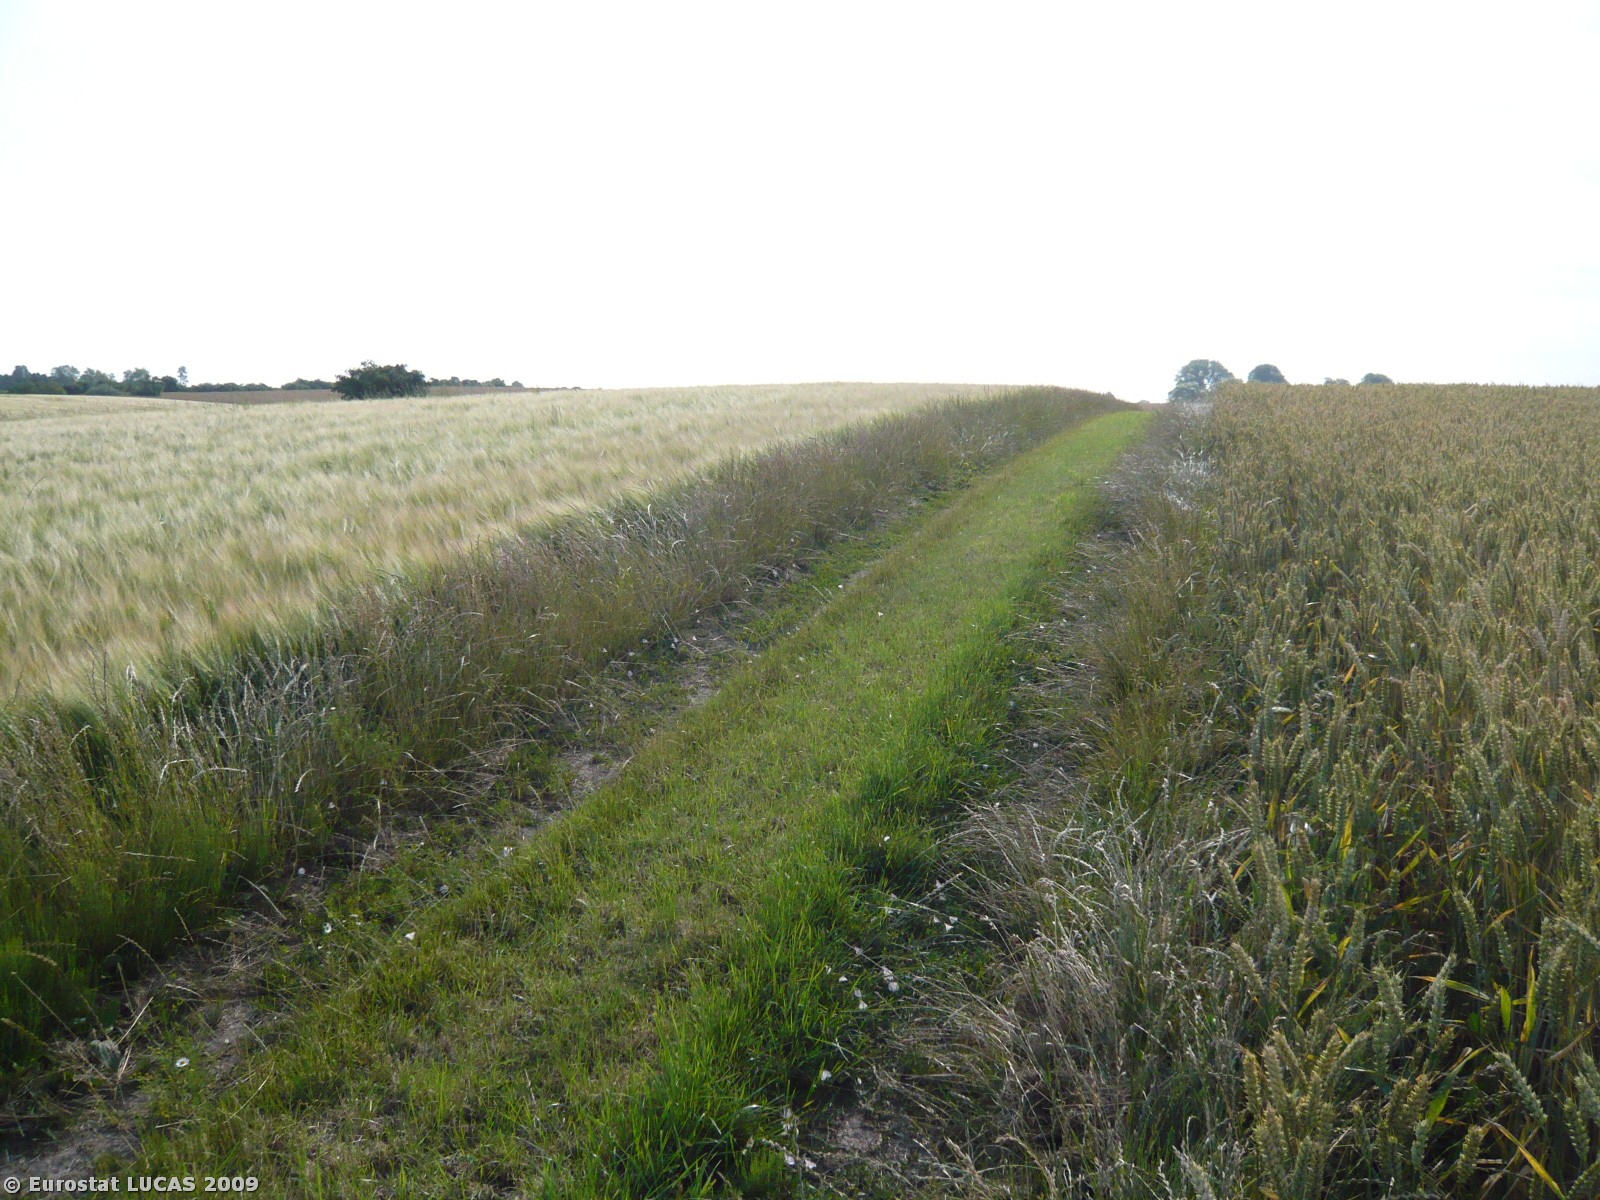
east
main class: Cropland
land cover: Common wheat
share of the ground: > 75 %
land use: Agriculture (excluding fallow land and kitchen gardens)
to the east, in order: Common wheat; Tracks; Barley; Rape and turnip rape
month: July
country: DK
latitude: 55.7325
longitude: 11.2250
